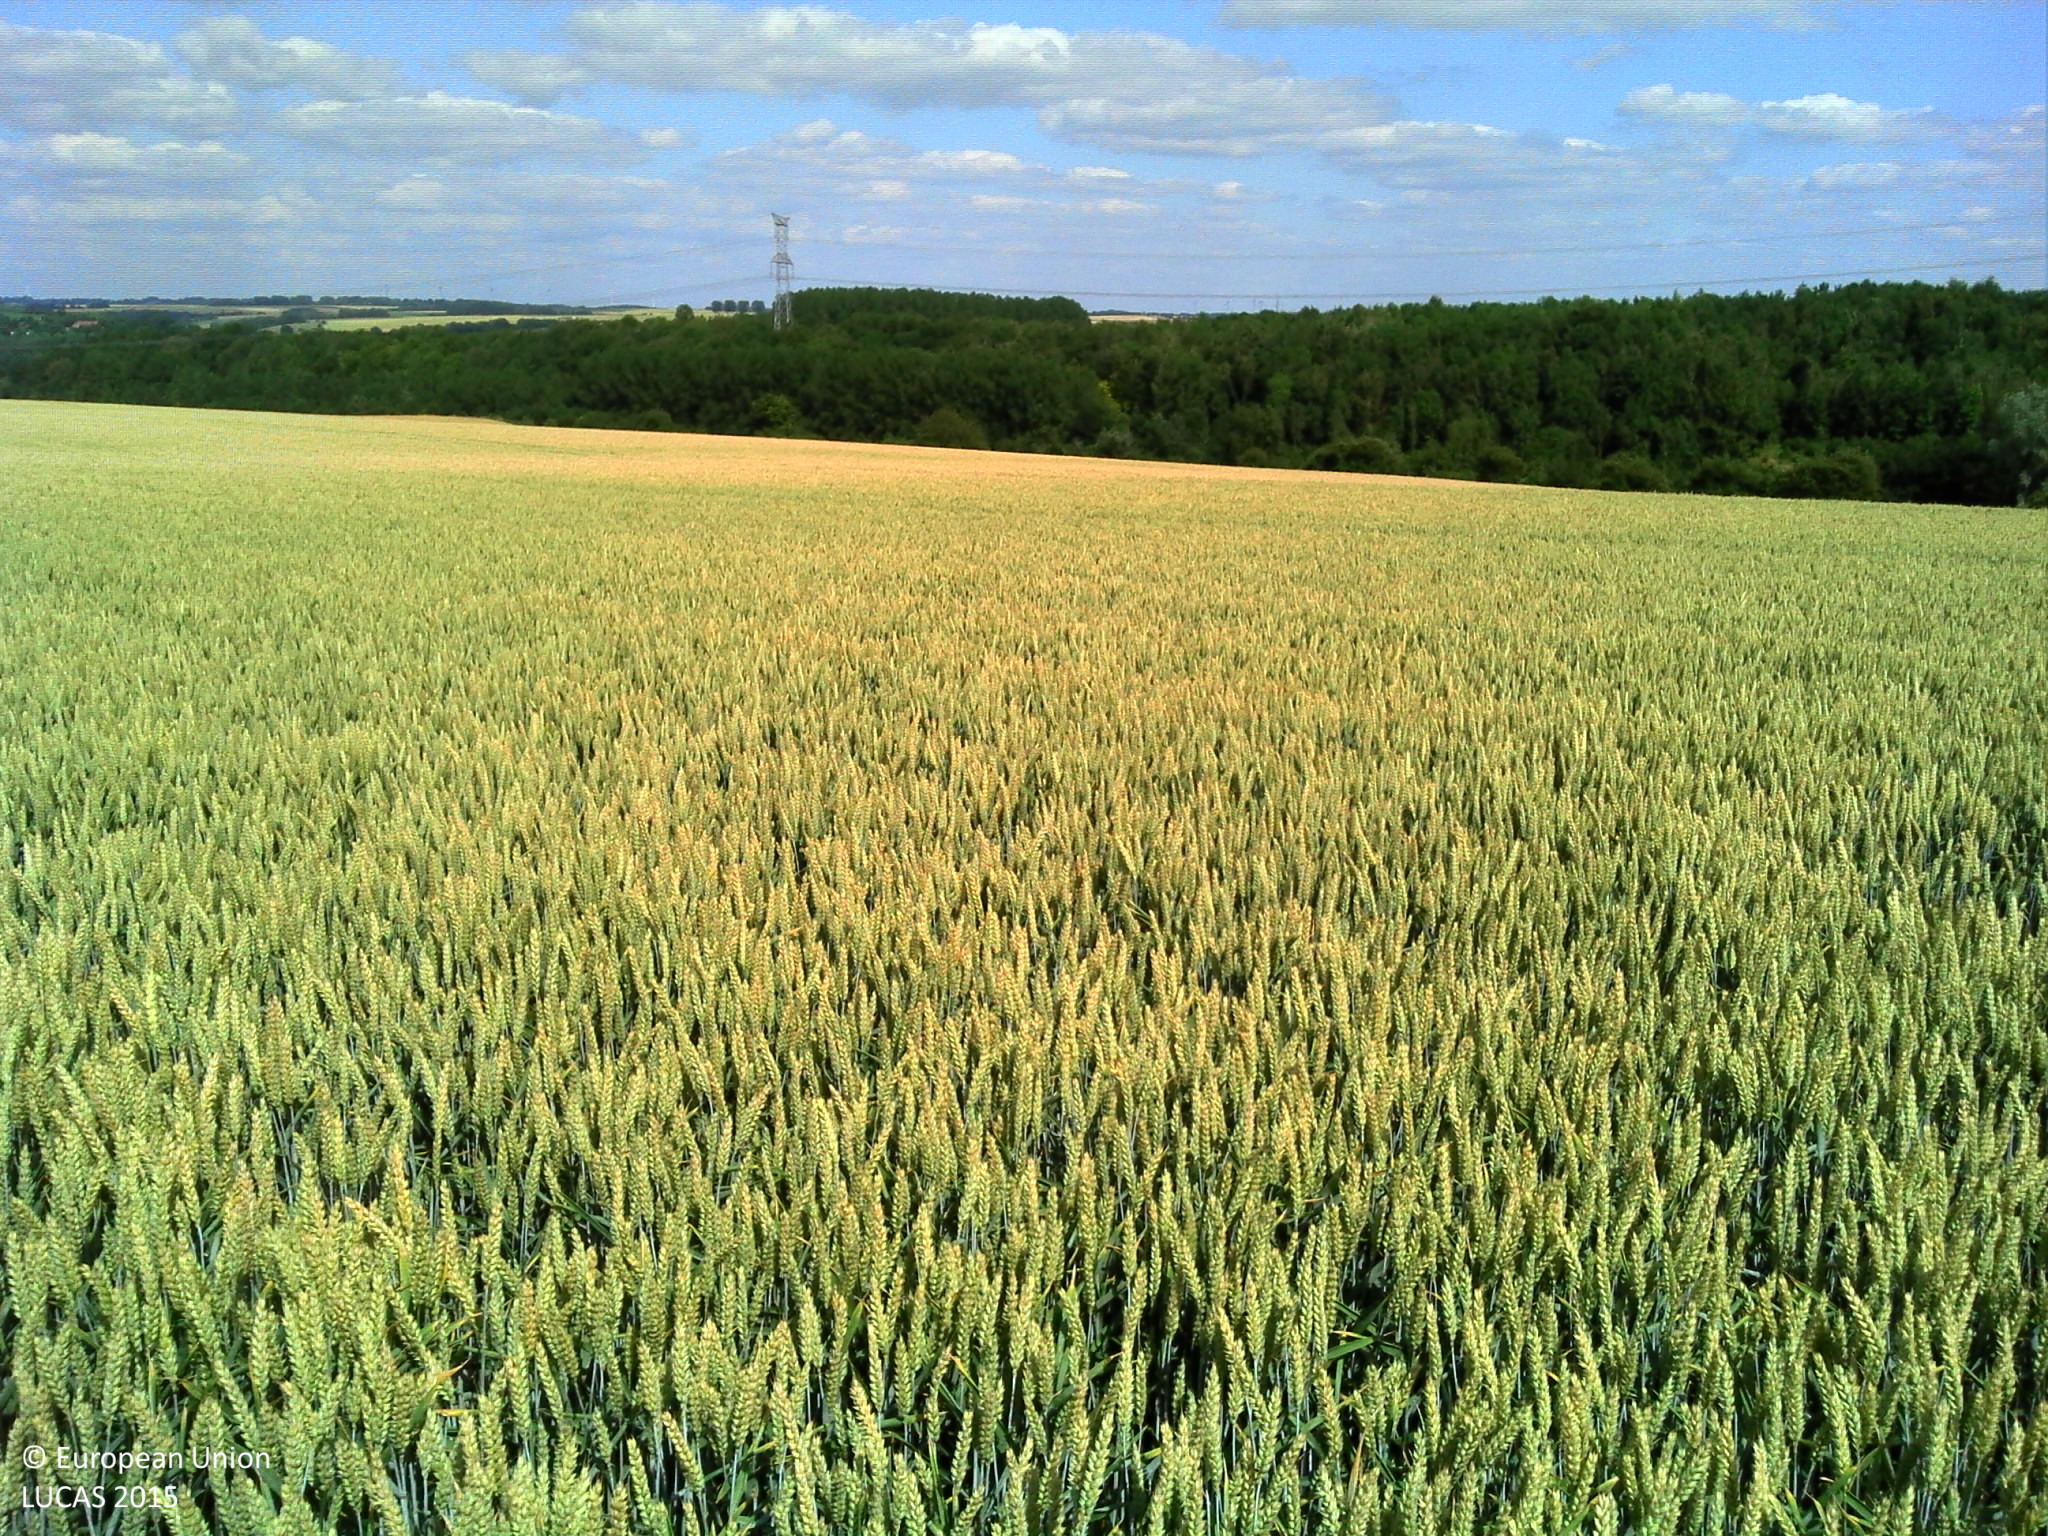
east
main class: Cropland
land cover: Common wheat
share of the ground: > 75 %
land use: Agriculture (excluding fallow land and kitchen gardens)
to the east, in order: Common wheat
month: July
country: FR
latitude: 50.3099
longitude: 2.1358
